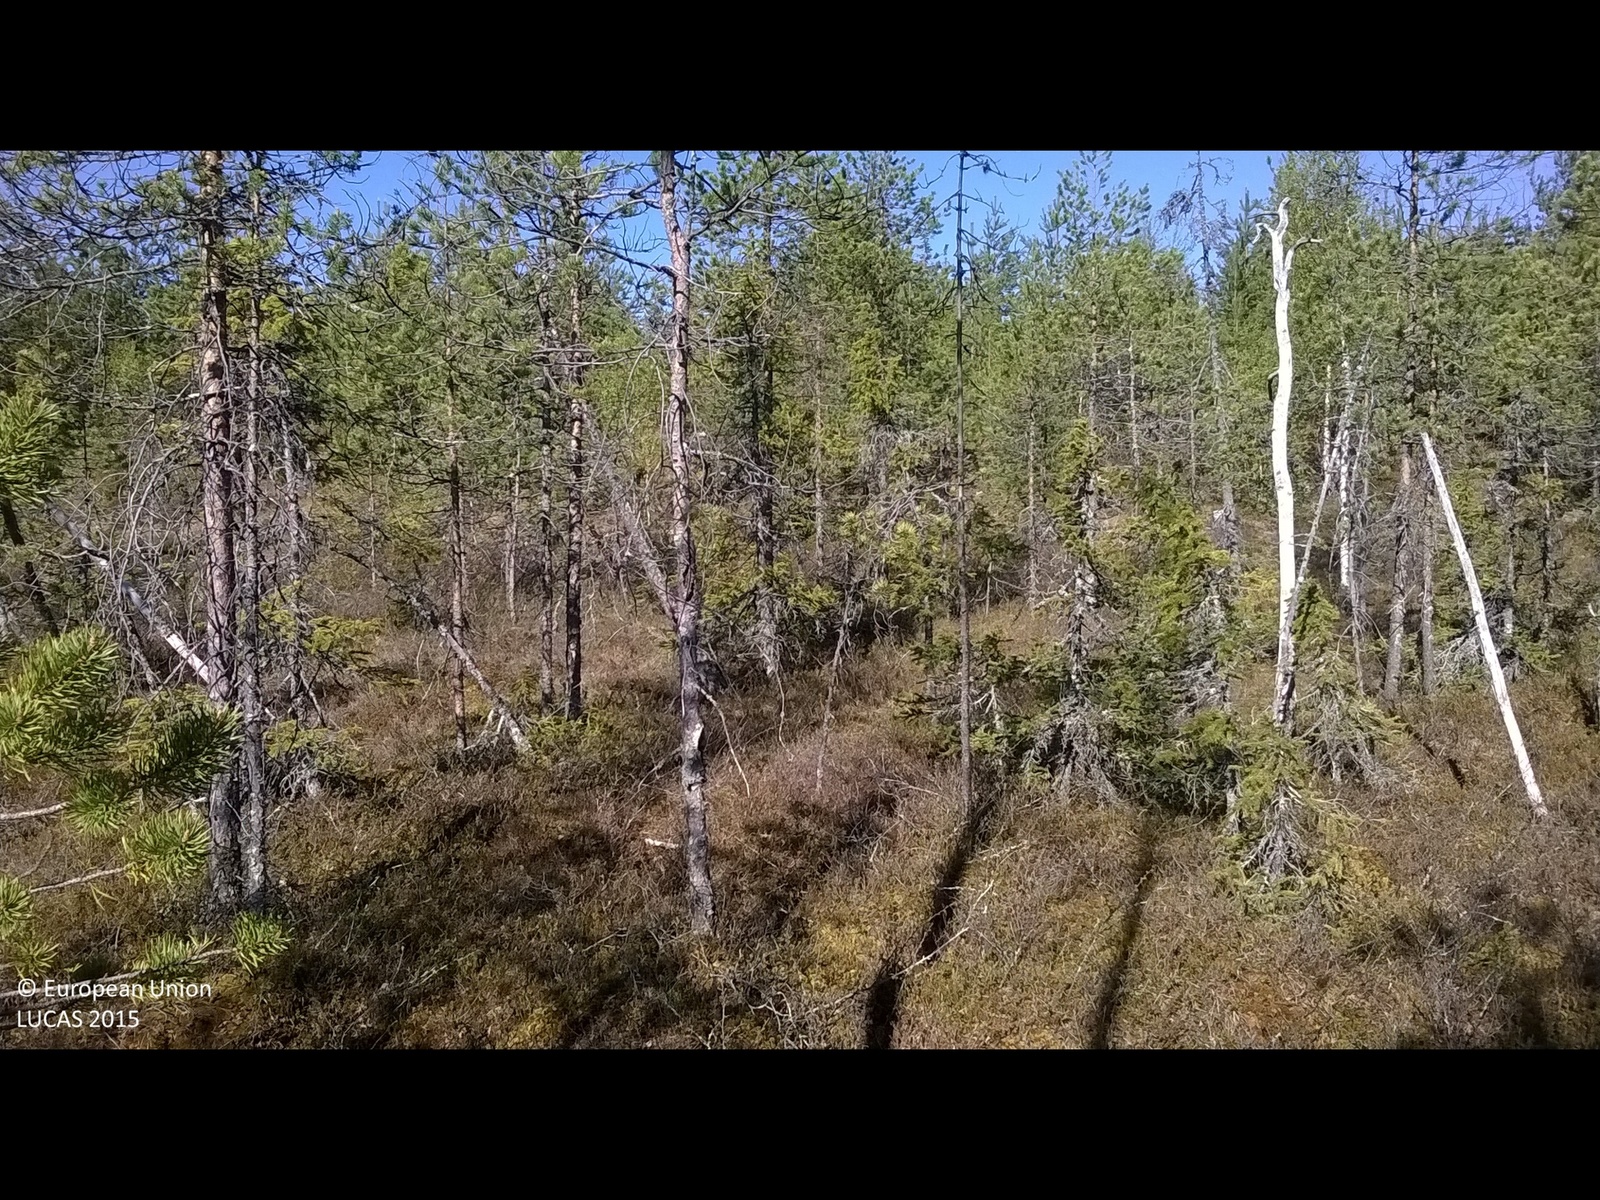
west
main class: Woodland
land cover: Pine dominated coniferous woodland
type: mire and swamp forests
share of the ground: 50 - 75 %
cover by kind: coniferous forest trees 50 %, shrubs 25 %, lichens and mosses 25 %
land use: Forestry
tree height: > 5 m
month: June
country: FI
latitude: 66.6395
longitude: 26.5622
